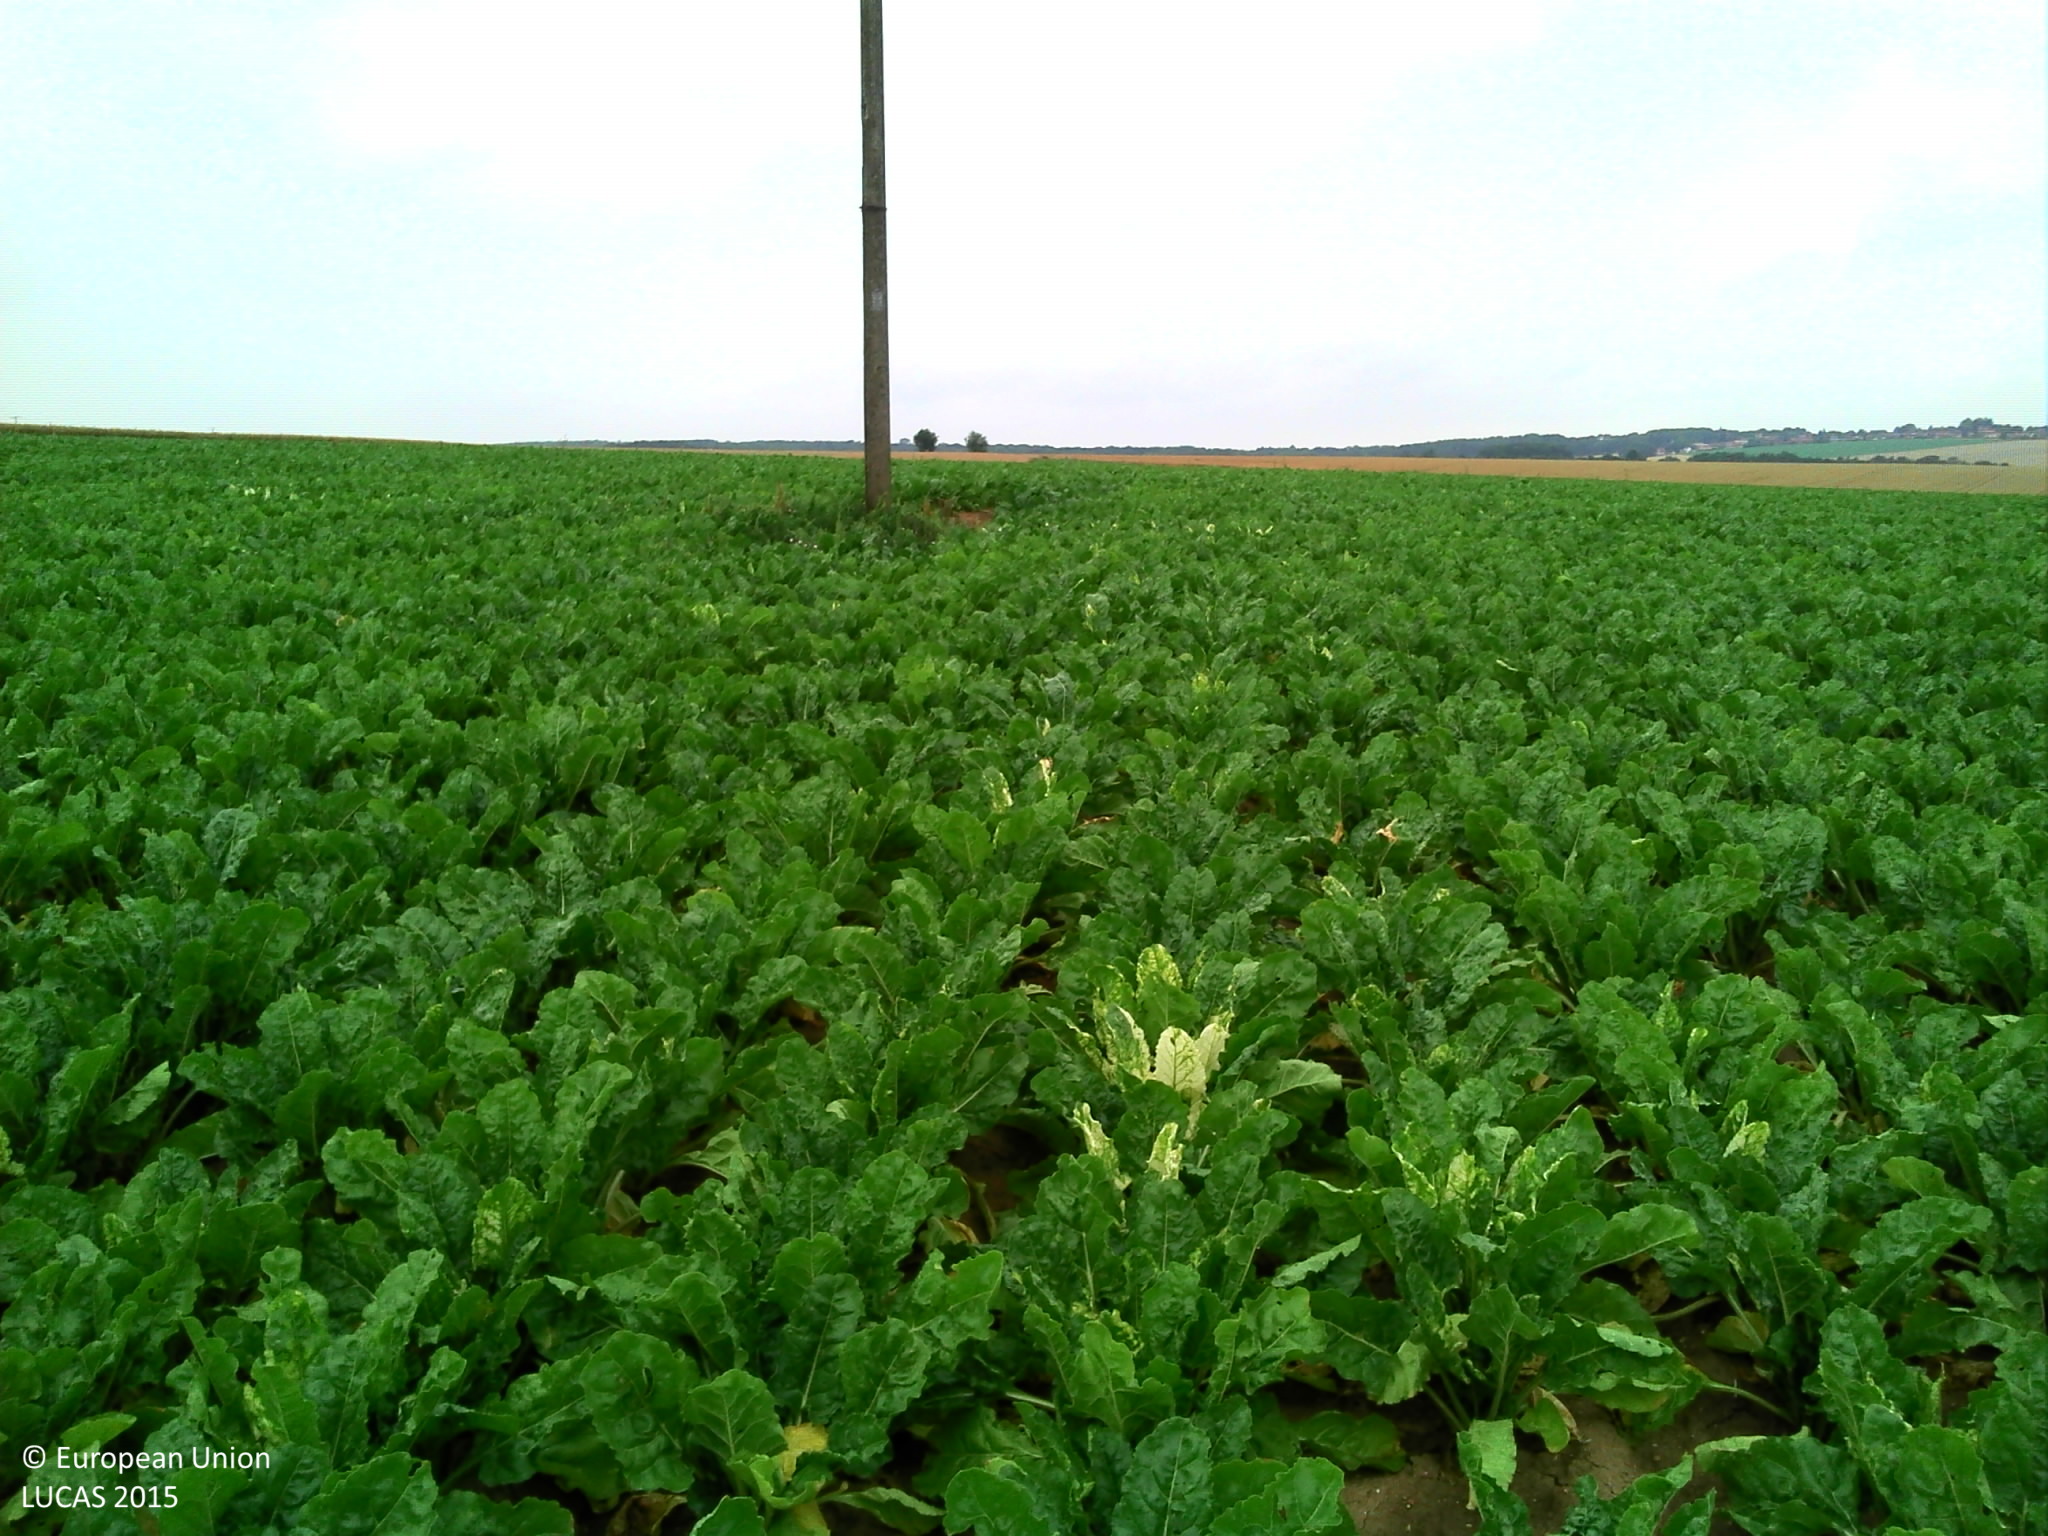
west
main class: Cropland
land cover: Sugar beet
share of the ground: > 75 %
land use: Agriculture (excluding fallow land and kitchen gardens)
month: July
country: FR
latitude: 50.1031
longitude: 3.1260
